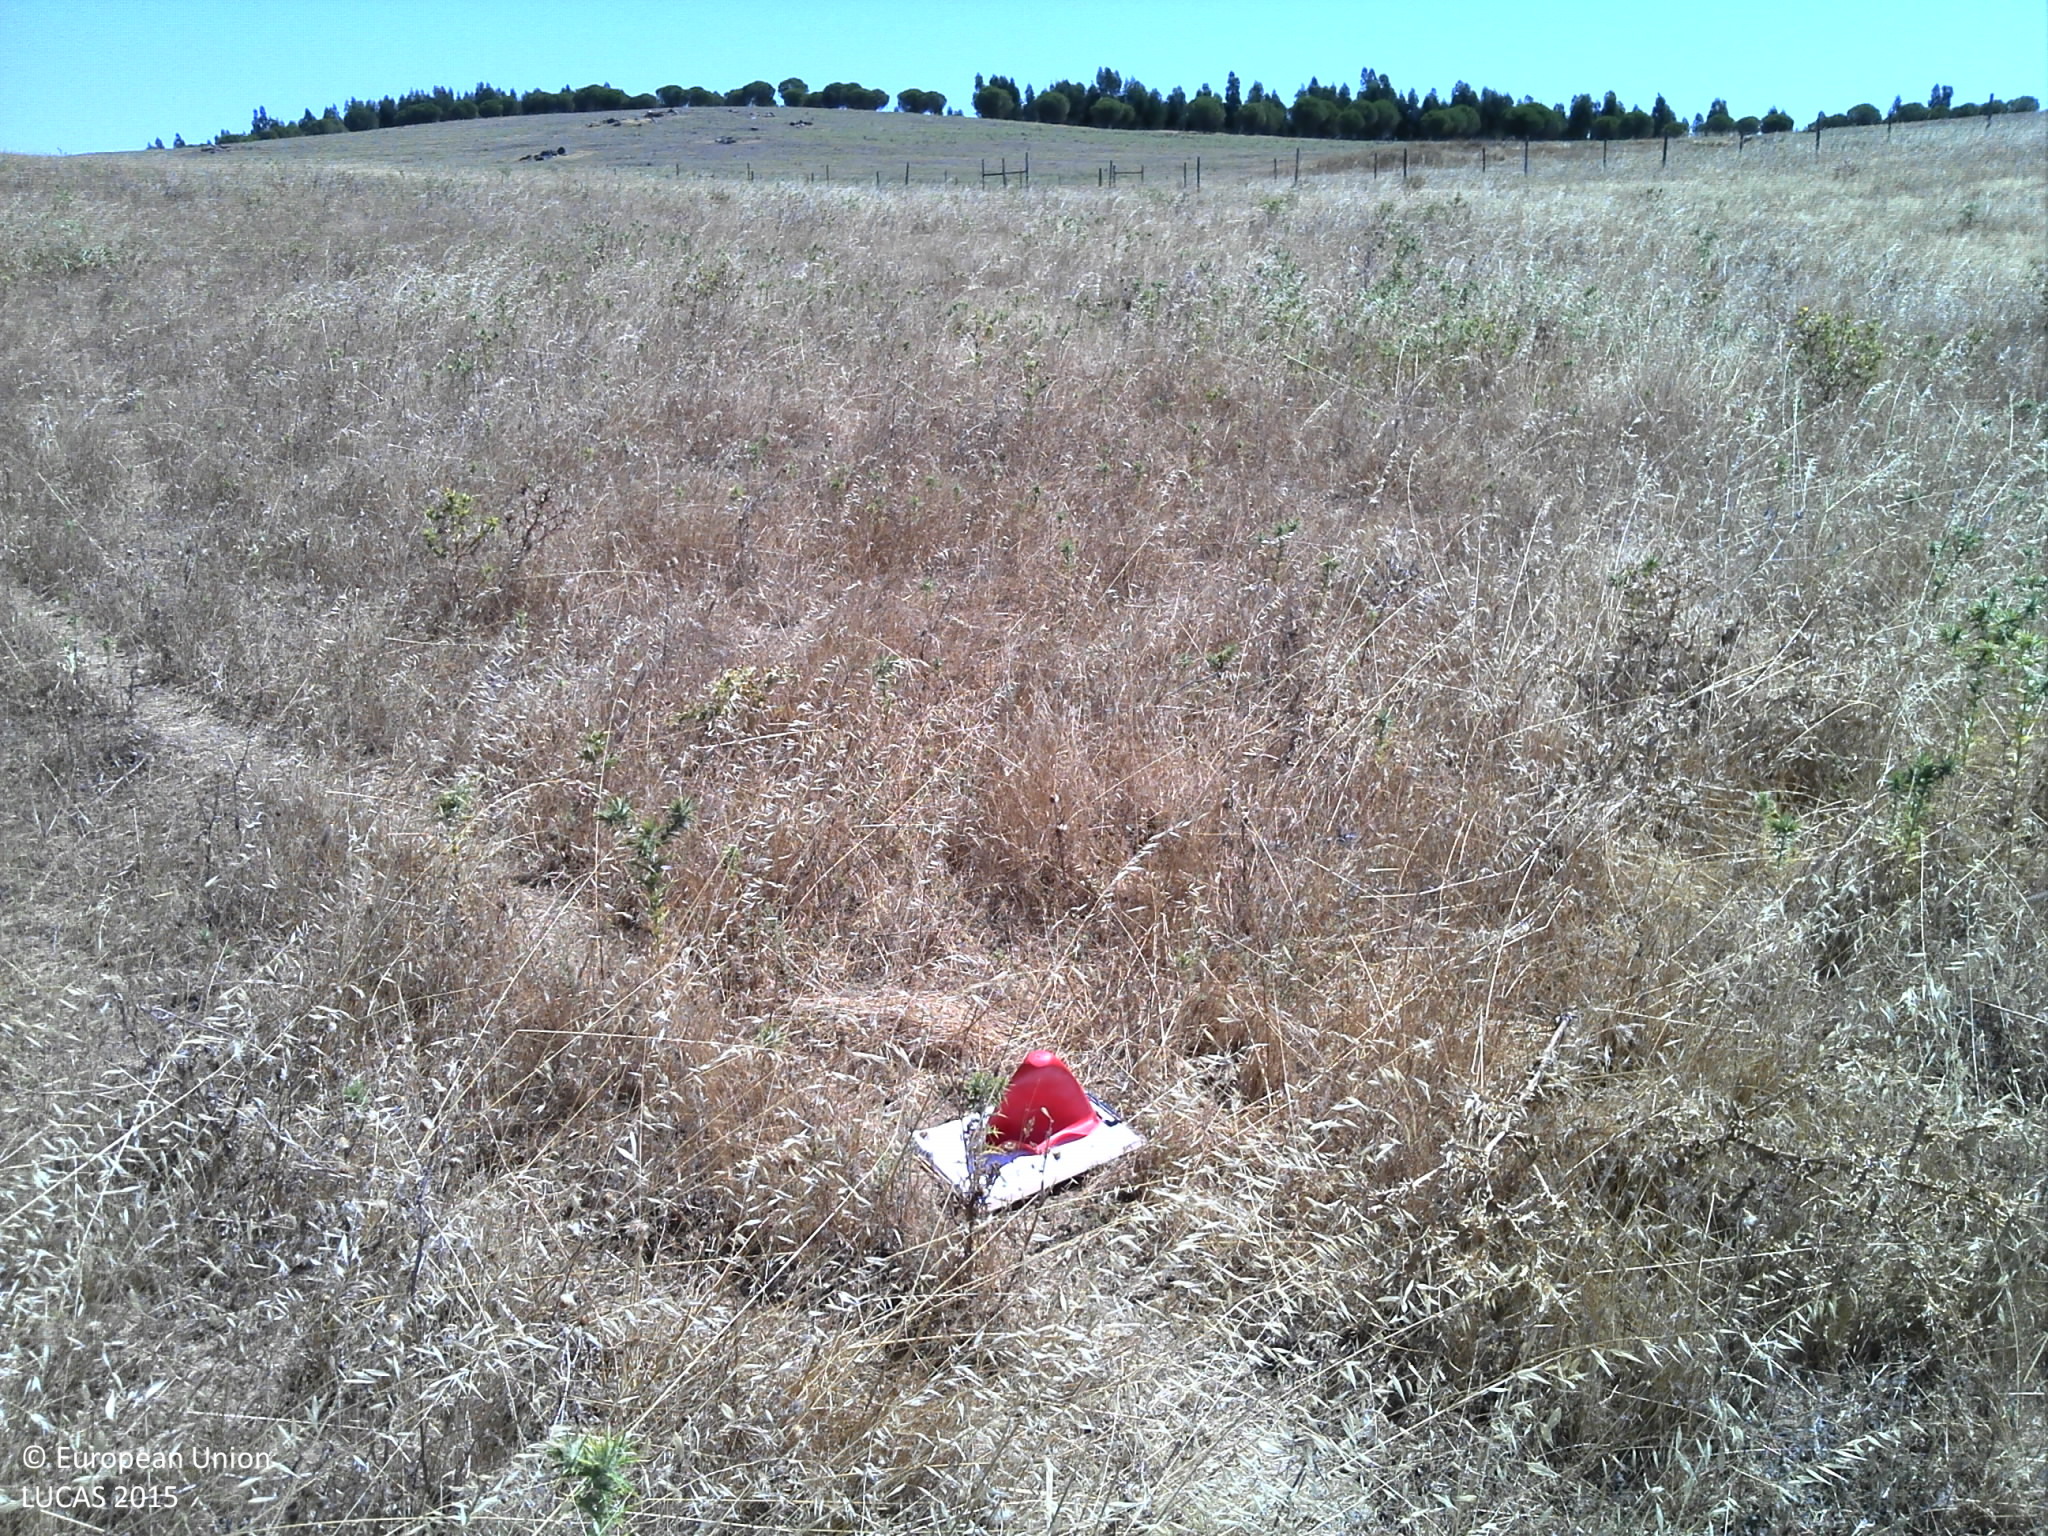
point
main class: Grassland
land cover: Grassland without tree/shrub cover
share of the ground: 50 - 75 %
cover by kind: herbaceous plants 70 %, unconsolidated bare surface 30 %
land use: Agriculture (excluding fallow land and kitchen gardens)
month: June
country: PT
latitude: 37.7883
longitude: -8.3045
